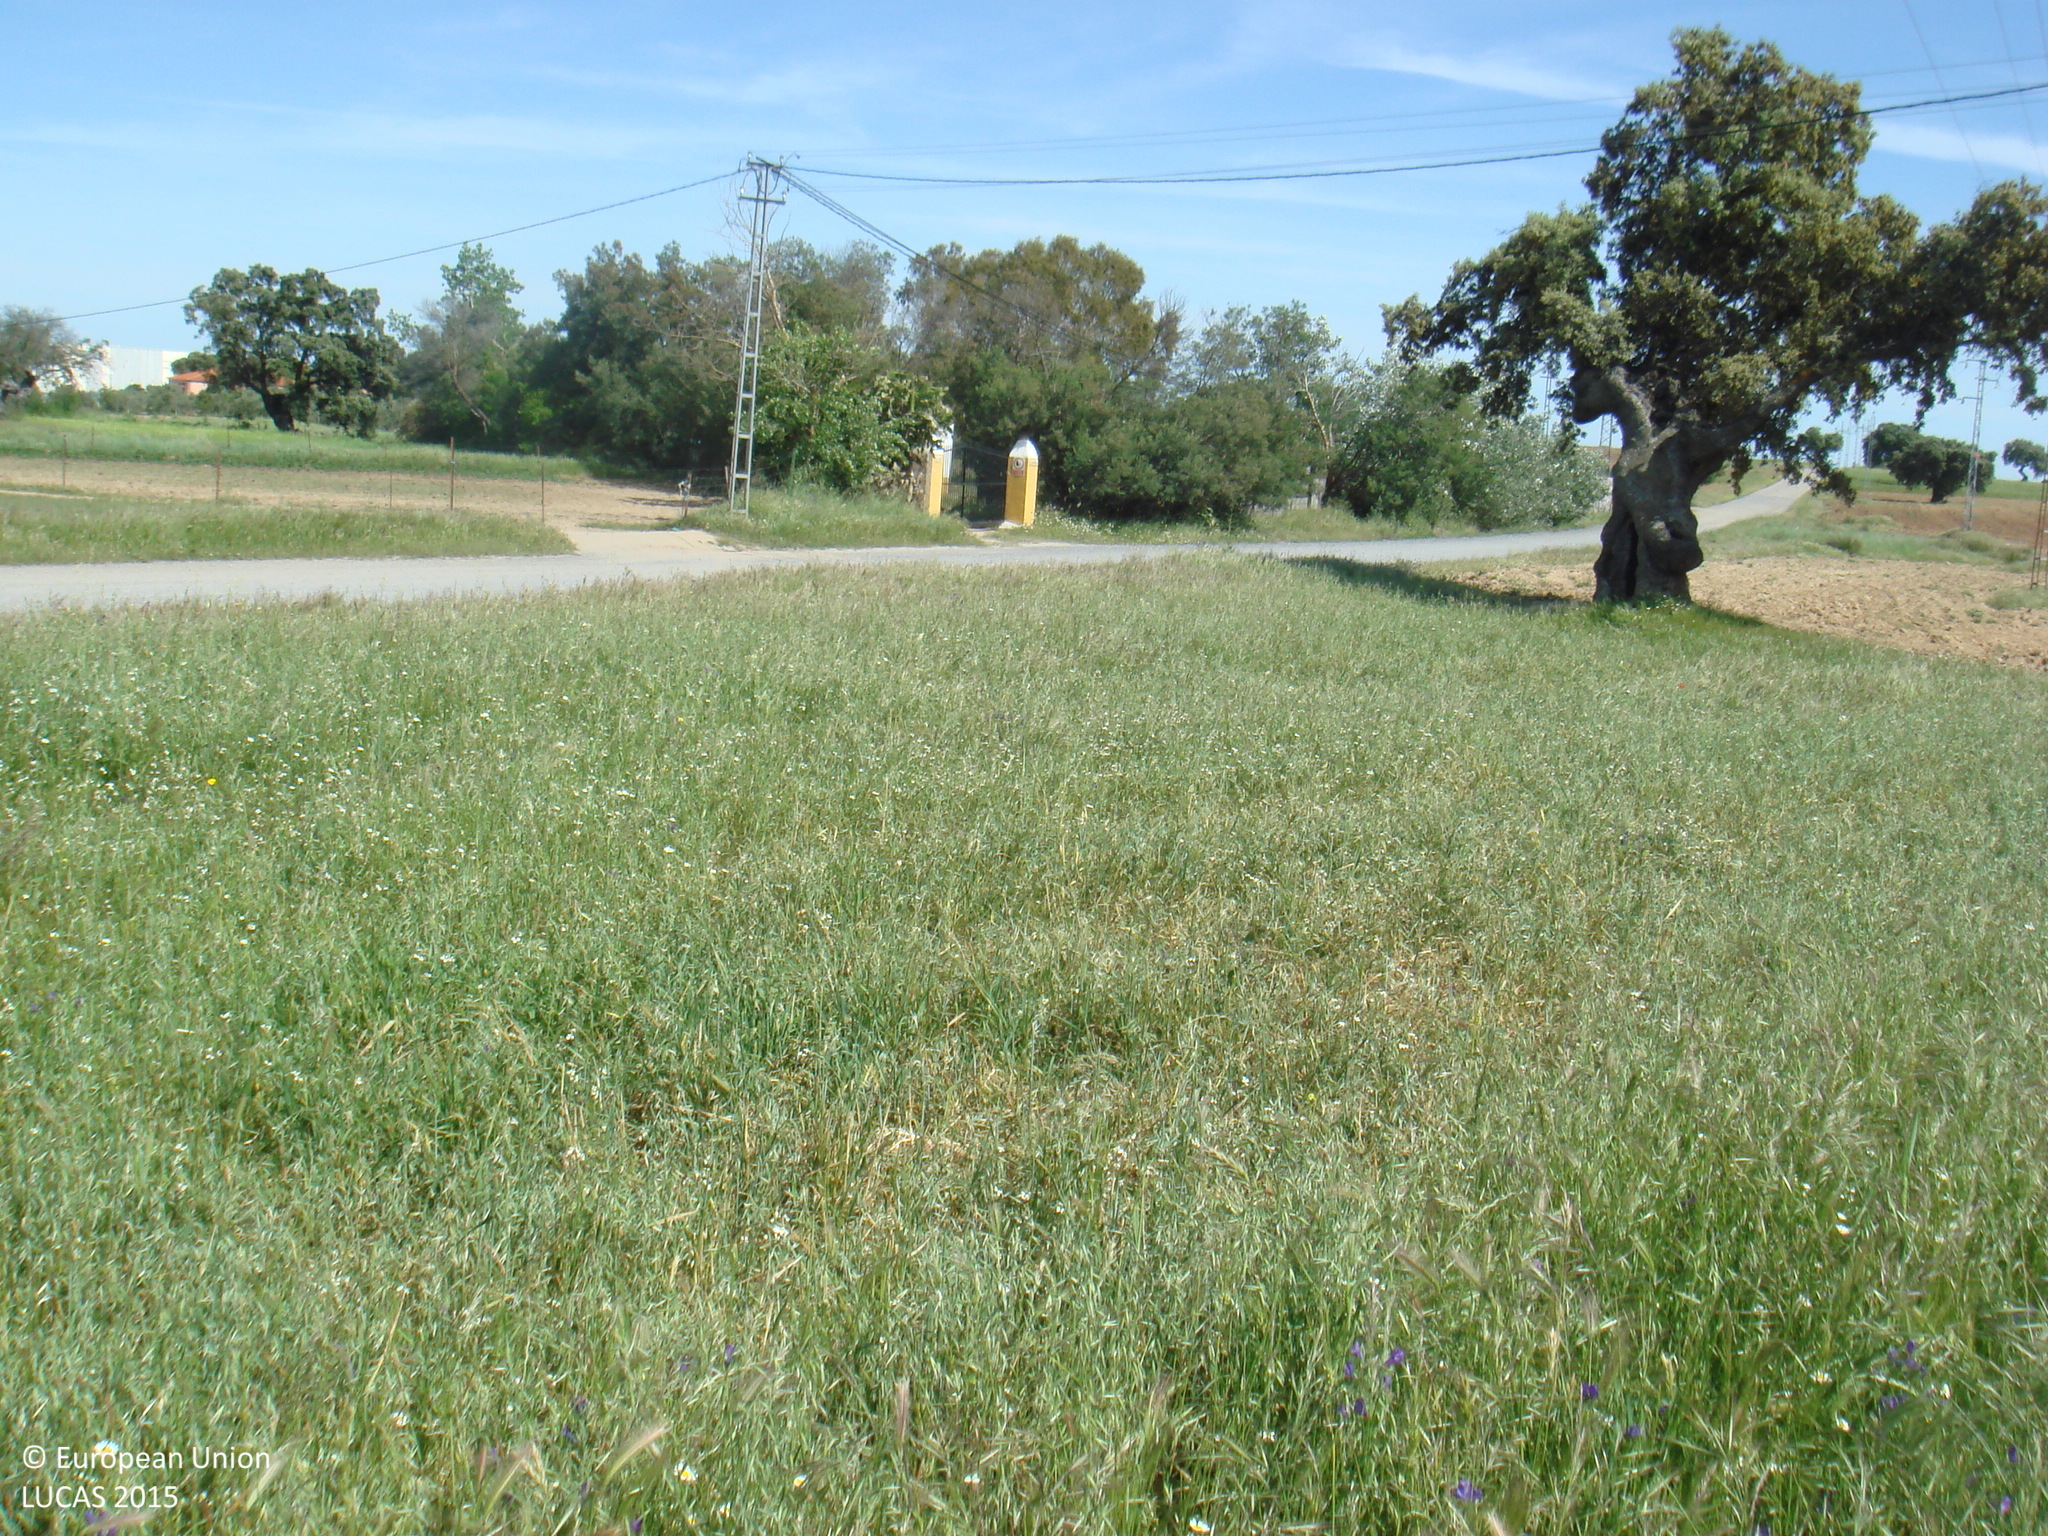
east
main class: Cropland
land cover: Mixed cereals for fodder
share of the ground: 25 - 50 %
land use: Agriculture (excluding fallow land and kitchen gardens)
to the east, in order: Mixed cereals for fodder; Tracks; Grass margins; Electric lines; Grass margins; Tracks; Grass margins; Fences; Spontaneously vegetated surfaces; Tracks; Artificial constructions in urban areas; Spontaneously vegetated surfaces; Tracks; Artificial constructions in urban areas; Spontaneously vegetated surfaces; Fences; Spontaneously vegetated surfaces; Arable land (only in case pi); Grassland with sparse tree/shrub cover; Spontaneously vegetated surfaces; Fences; Permanent crops (only in case pi); Fences; Spontaneously vegetated surfaces
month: April
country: ES
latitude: 38.4804
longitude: -5.1263
